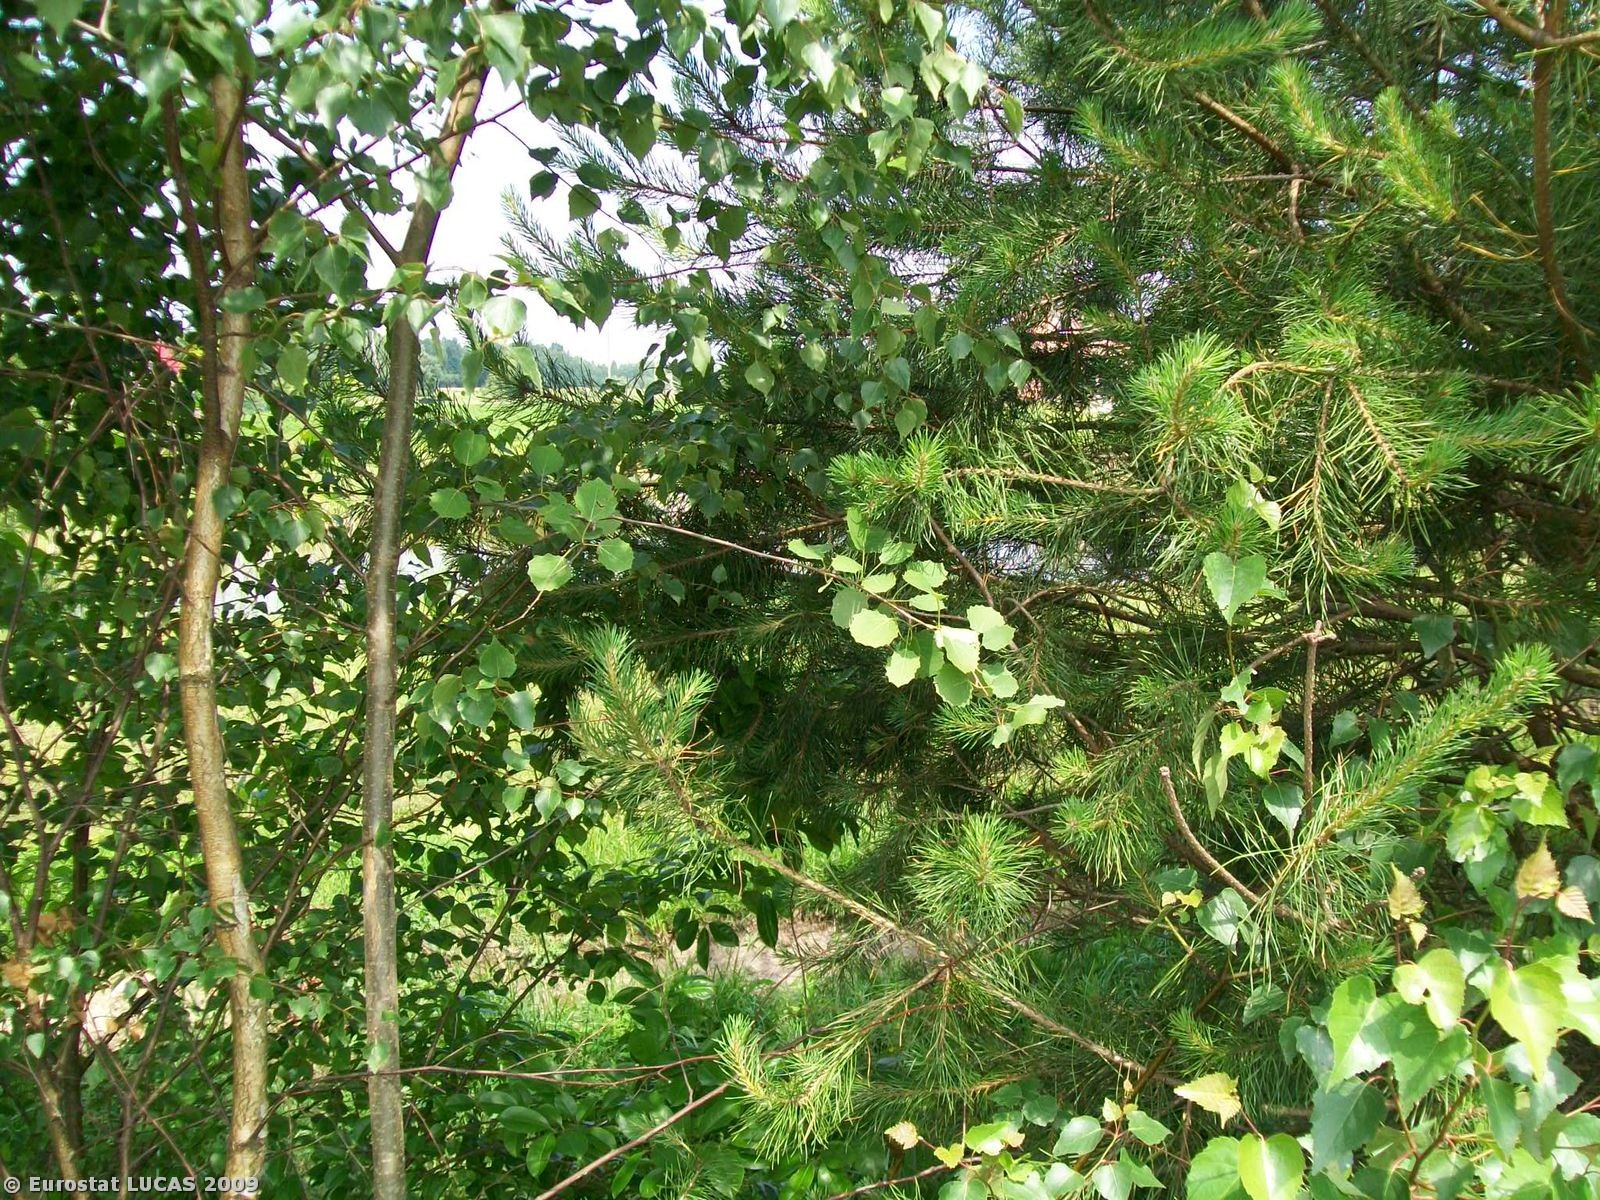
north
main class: Cropland
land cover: Other cereals
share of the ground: > 75 %
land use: Agriculture (excluding fallow land and kitchen gardens)
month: June
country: PL
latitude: 51.5439
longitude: 15.1799
